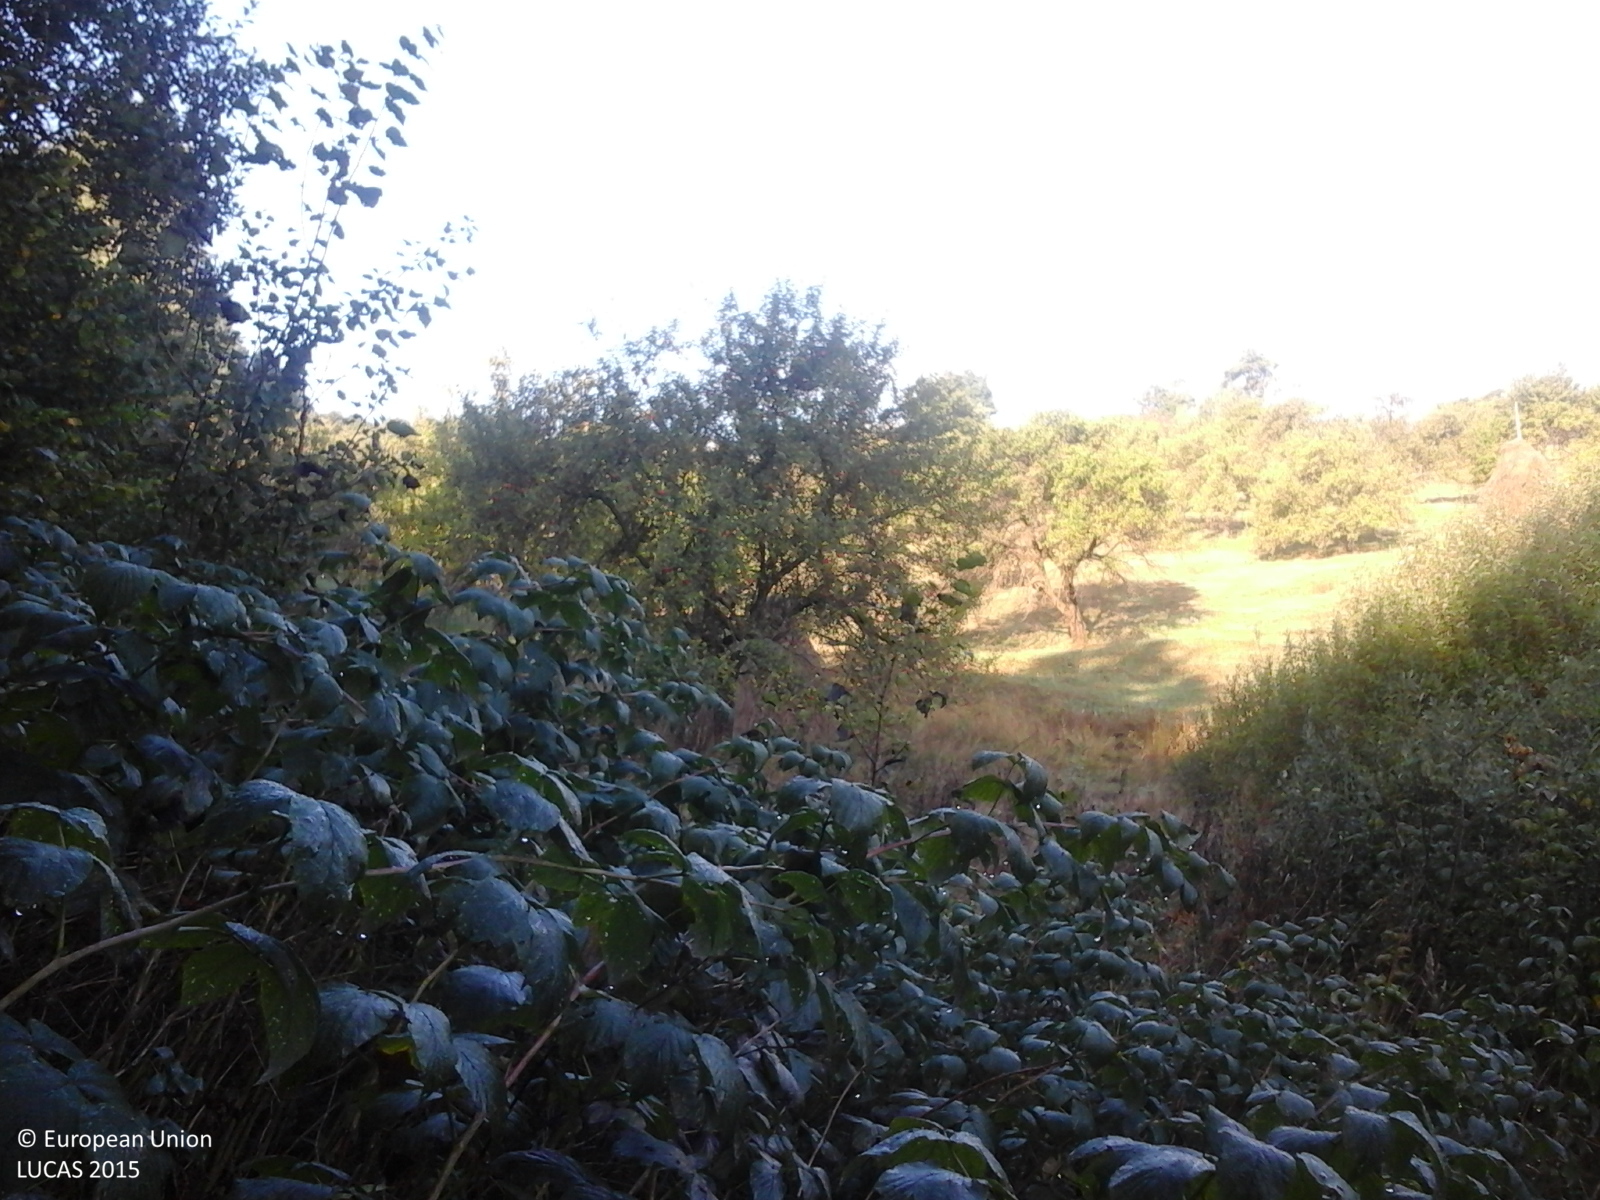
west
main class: Woodland
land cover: Broadleaved woodland
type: non-riverine alder, birch or aspen forest
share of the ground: > 75 %
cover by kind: broadleaved forest trees 100 %
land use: Forestry
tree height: > 5 m
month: September
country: RO
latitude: 45.1094
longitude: 22.3053
